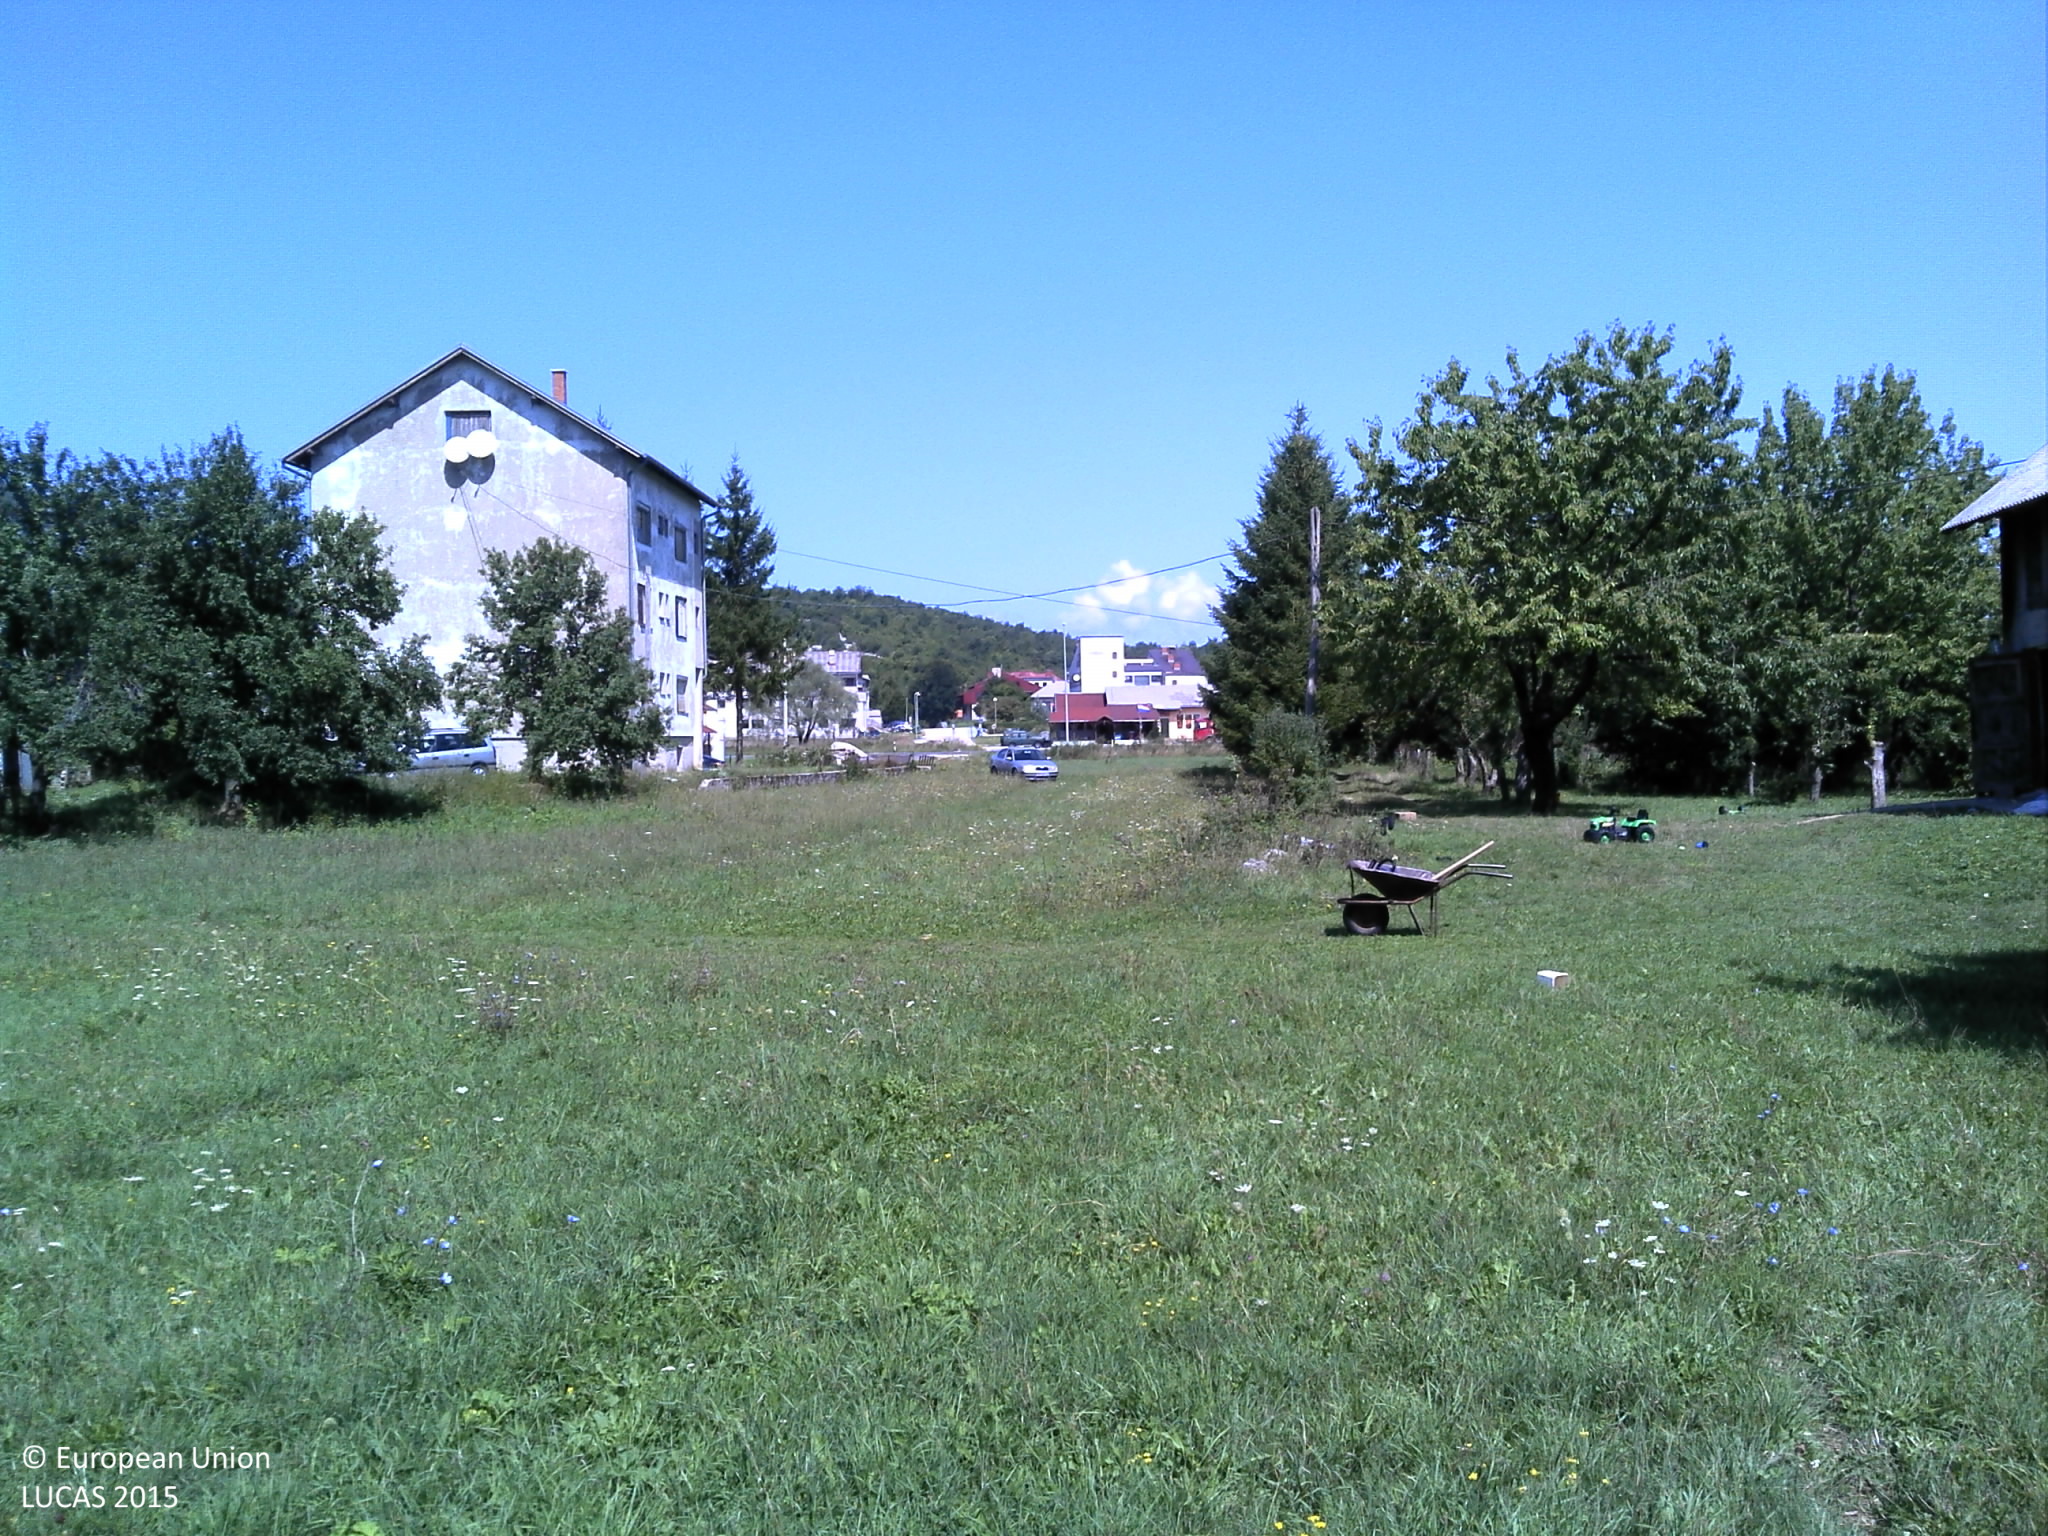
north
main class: Grassland
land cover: Grassland without tree/shrub cover
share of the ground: > 75 %
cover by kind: herbaceous plants 100 %
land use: Agriculture (excluding fallow land and kitchen gardens)
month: August
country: HR
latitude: 44.2942
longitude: 15.8459
